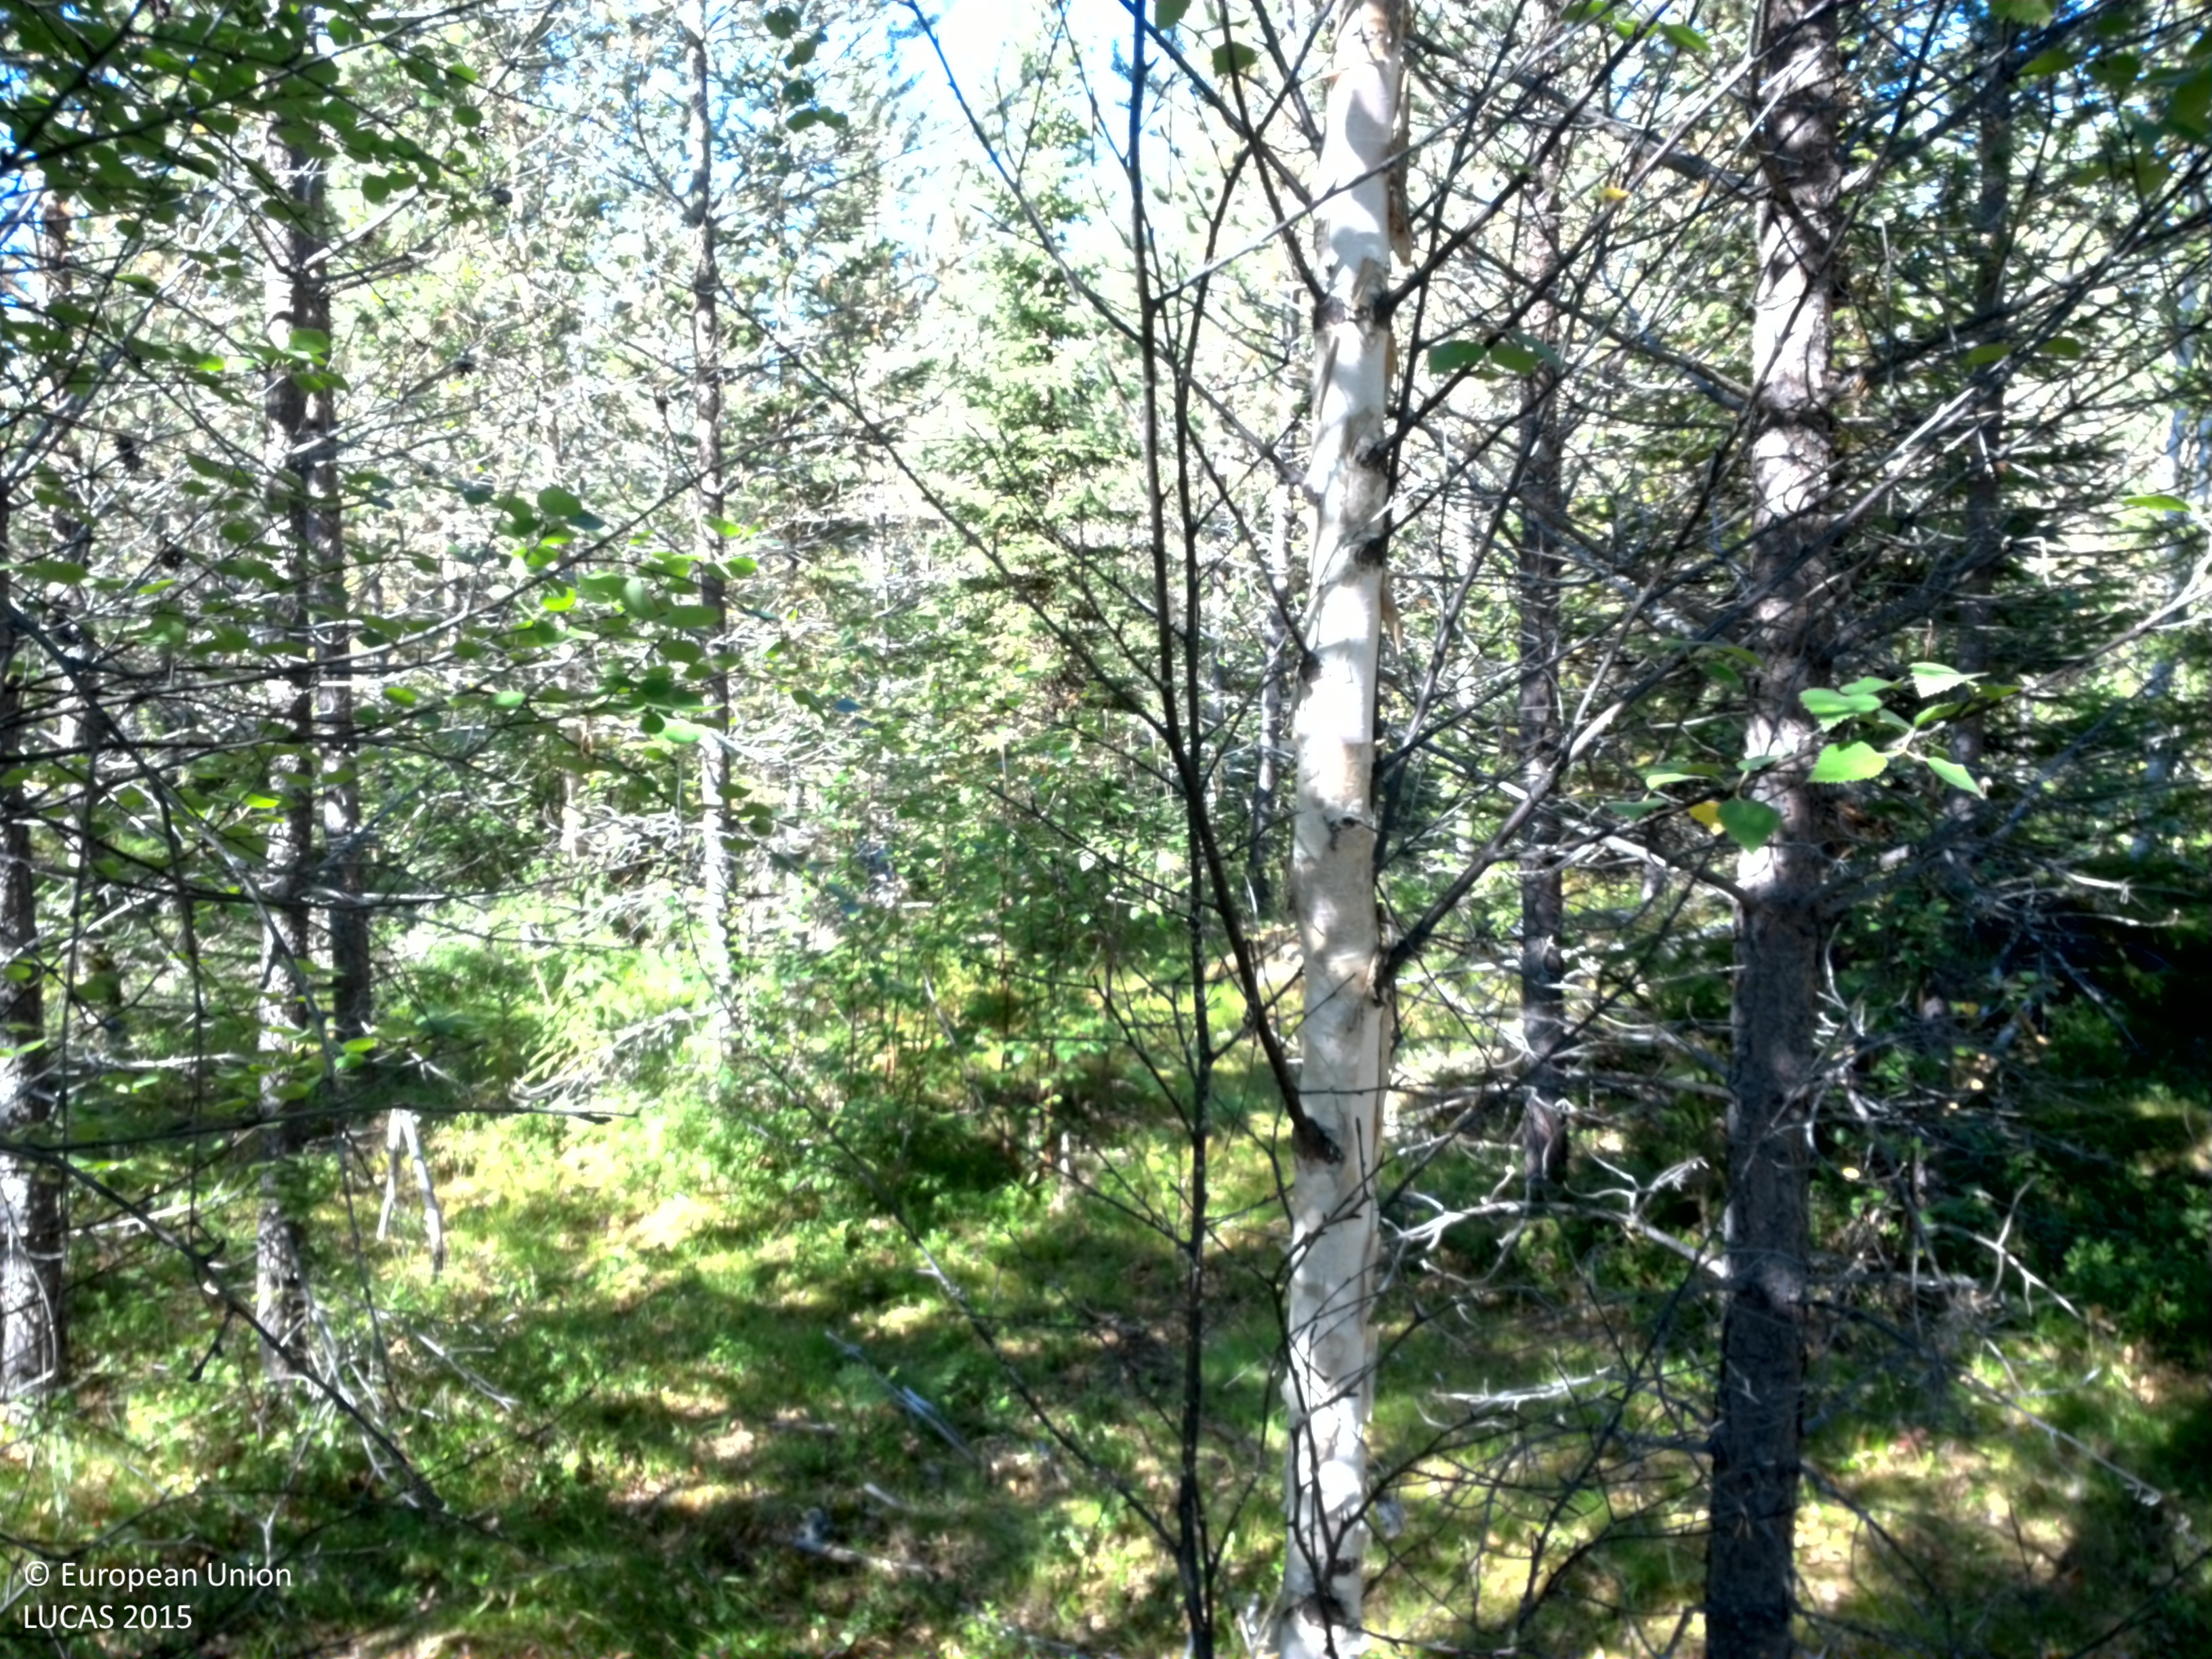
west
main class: Woodland
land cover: Pine dominated coniferous woodland
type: boreal forest
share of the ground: 50 - 75 %
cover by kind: coniferous forest trees 50 %, herbaceous plants 20 %, shrubs 15 %, lichens and mosses 10 %, broadleaved forest trees 5 %
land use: Forestry
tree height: > 5 m
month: August
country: SE
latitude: 64.7902
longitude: 16.0481
